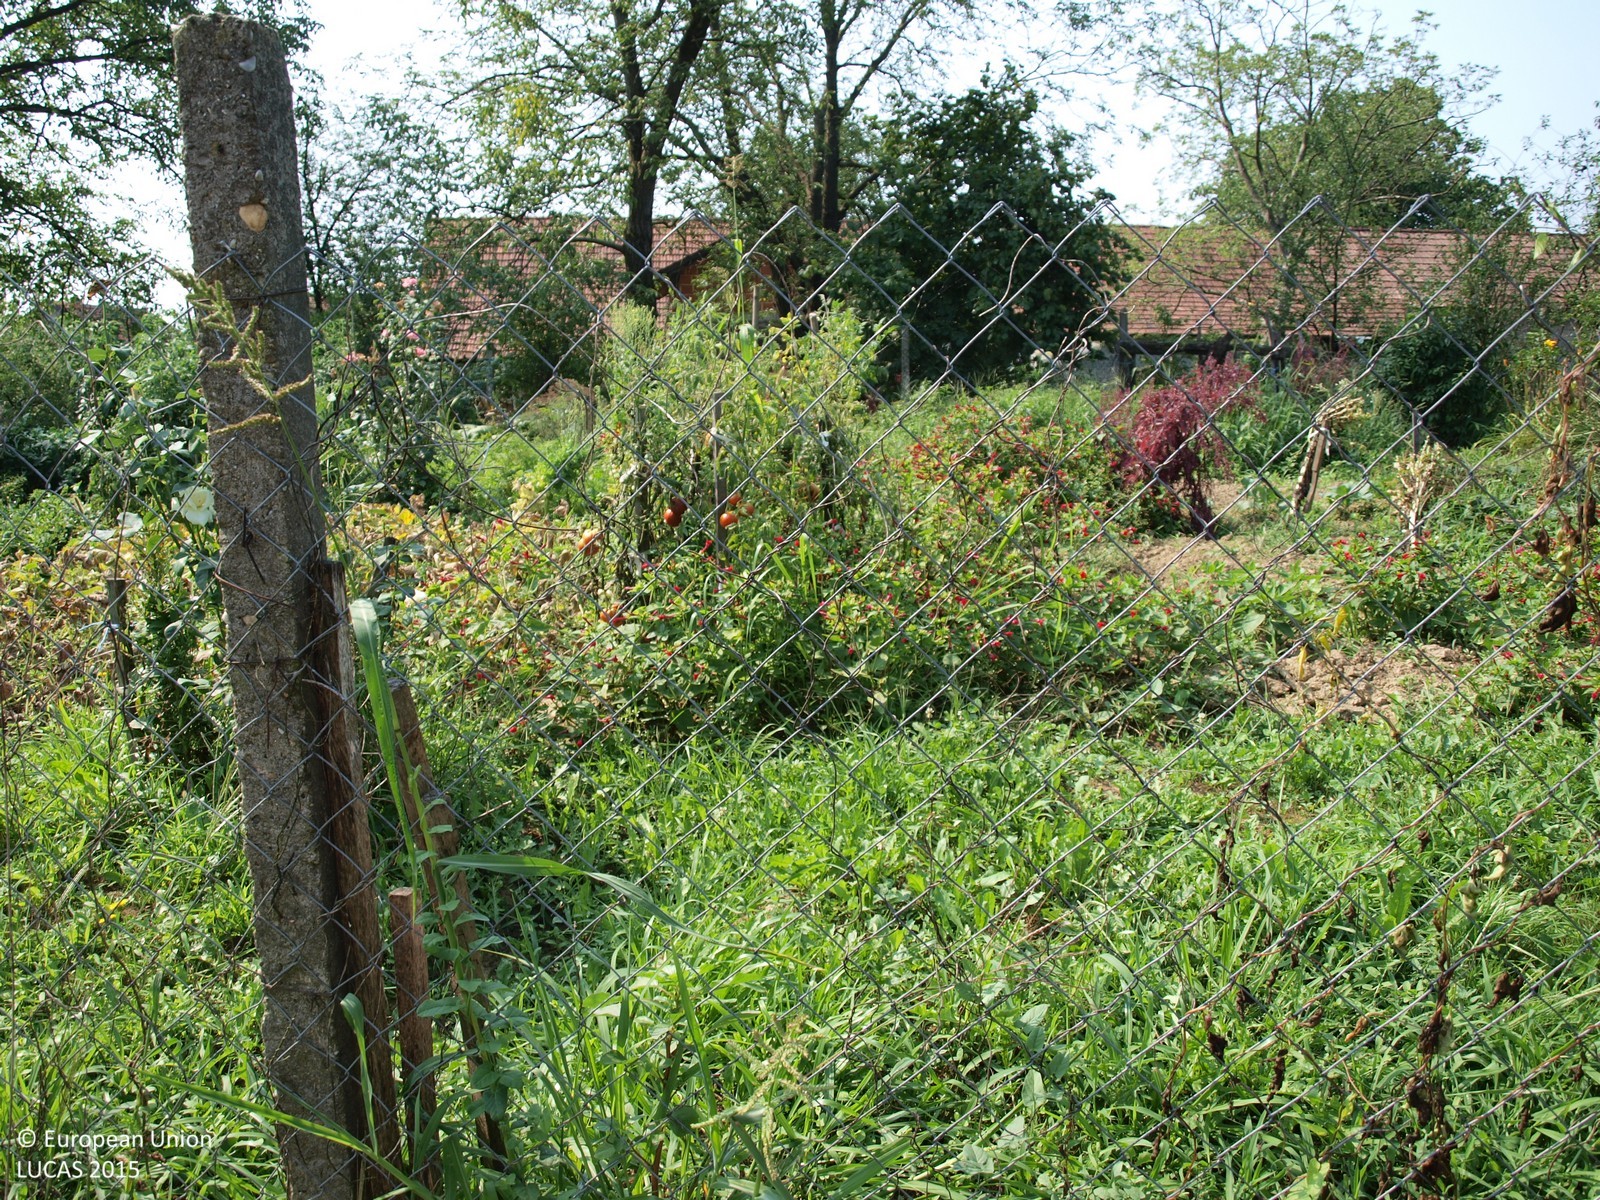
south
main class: Cropland
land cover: Tomatoes
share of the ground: > 75 %
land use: Kitchen garden
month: August
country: HR
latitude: 45.9046
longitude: 16.4315
